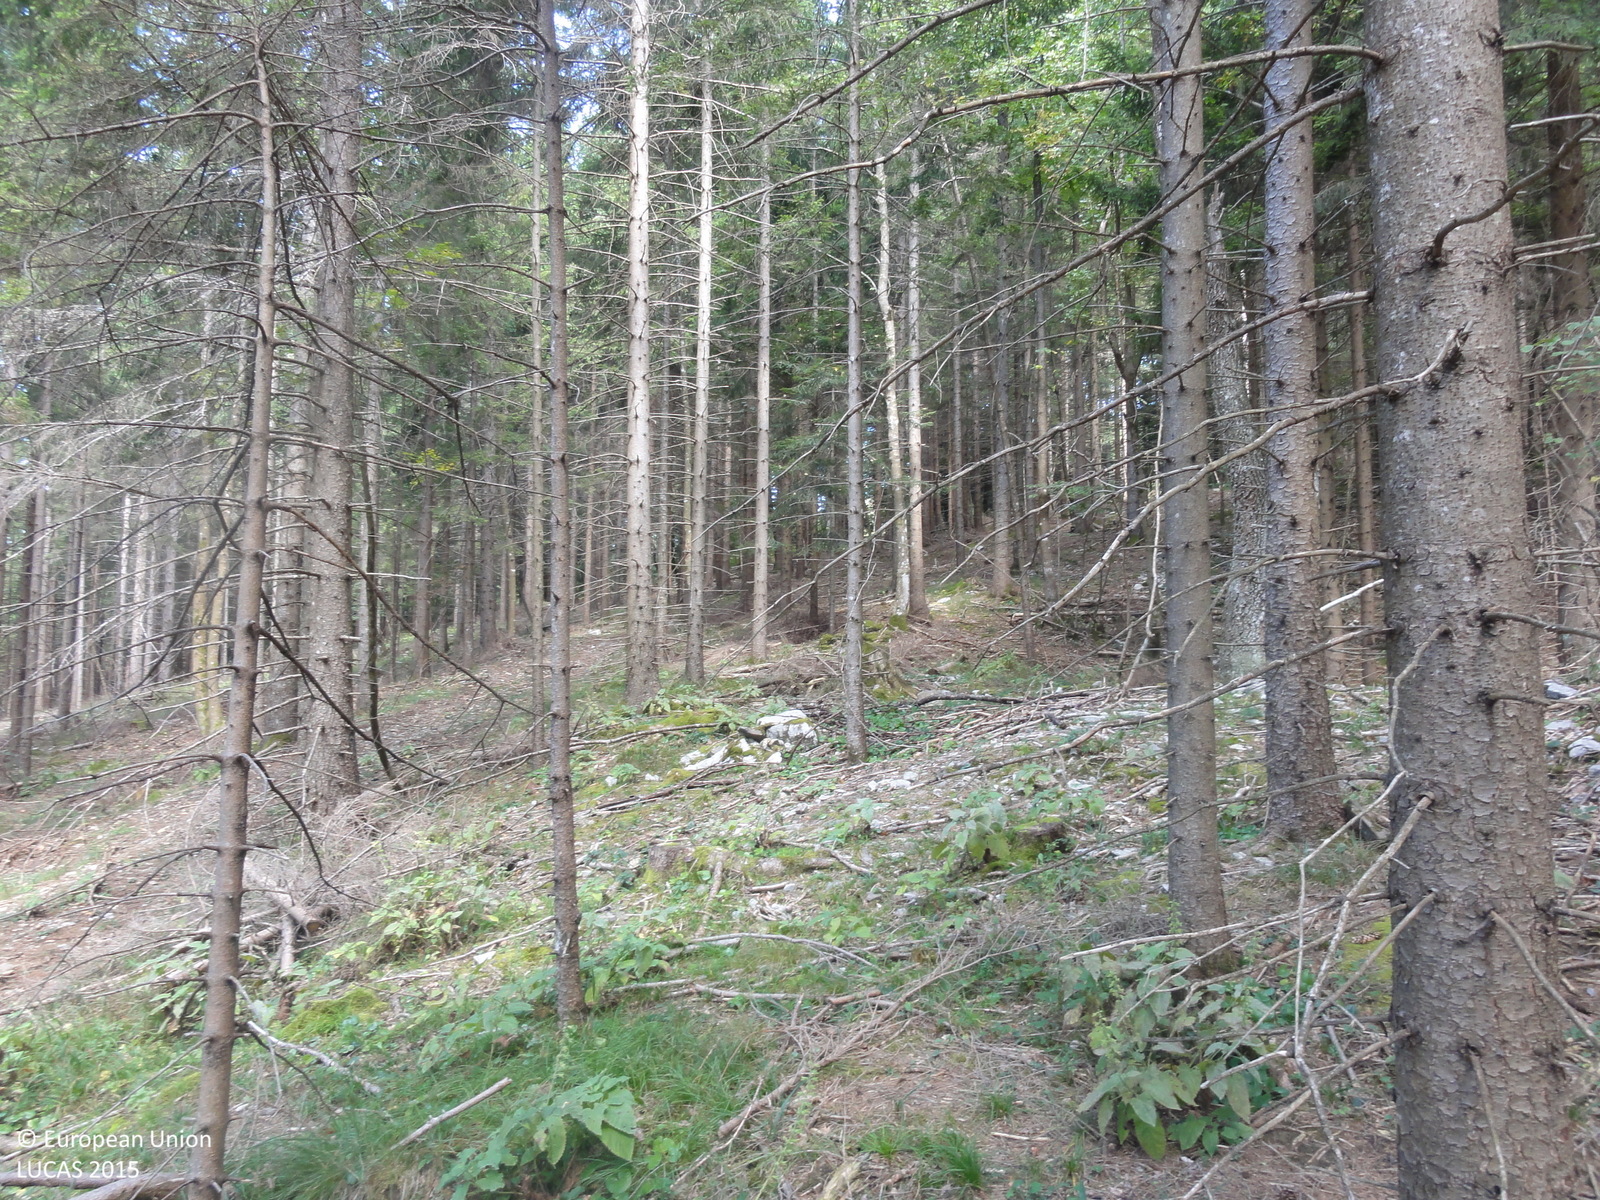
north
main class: Woodland
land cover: Spruce dominated coniferous woodland
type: hemiboreal forest and nemoral coniferous forest and mixed broadleaved-coniferous forest
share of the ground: > 75 %
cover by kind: coniferous forest trees 85 %, unconsolidated bare surface 10 %, broadleaved forest trees 5 %
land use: Forestry
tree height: > 5 m
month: September
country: SI
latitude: 45.7280
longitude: 15.0204
